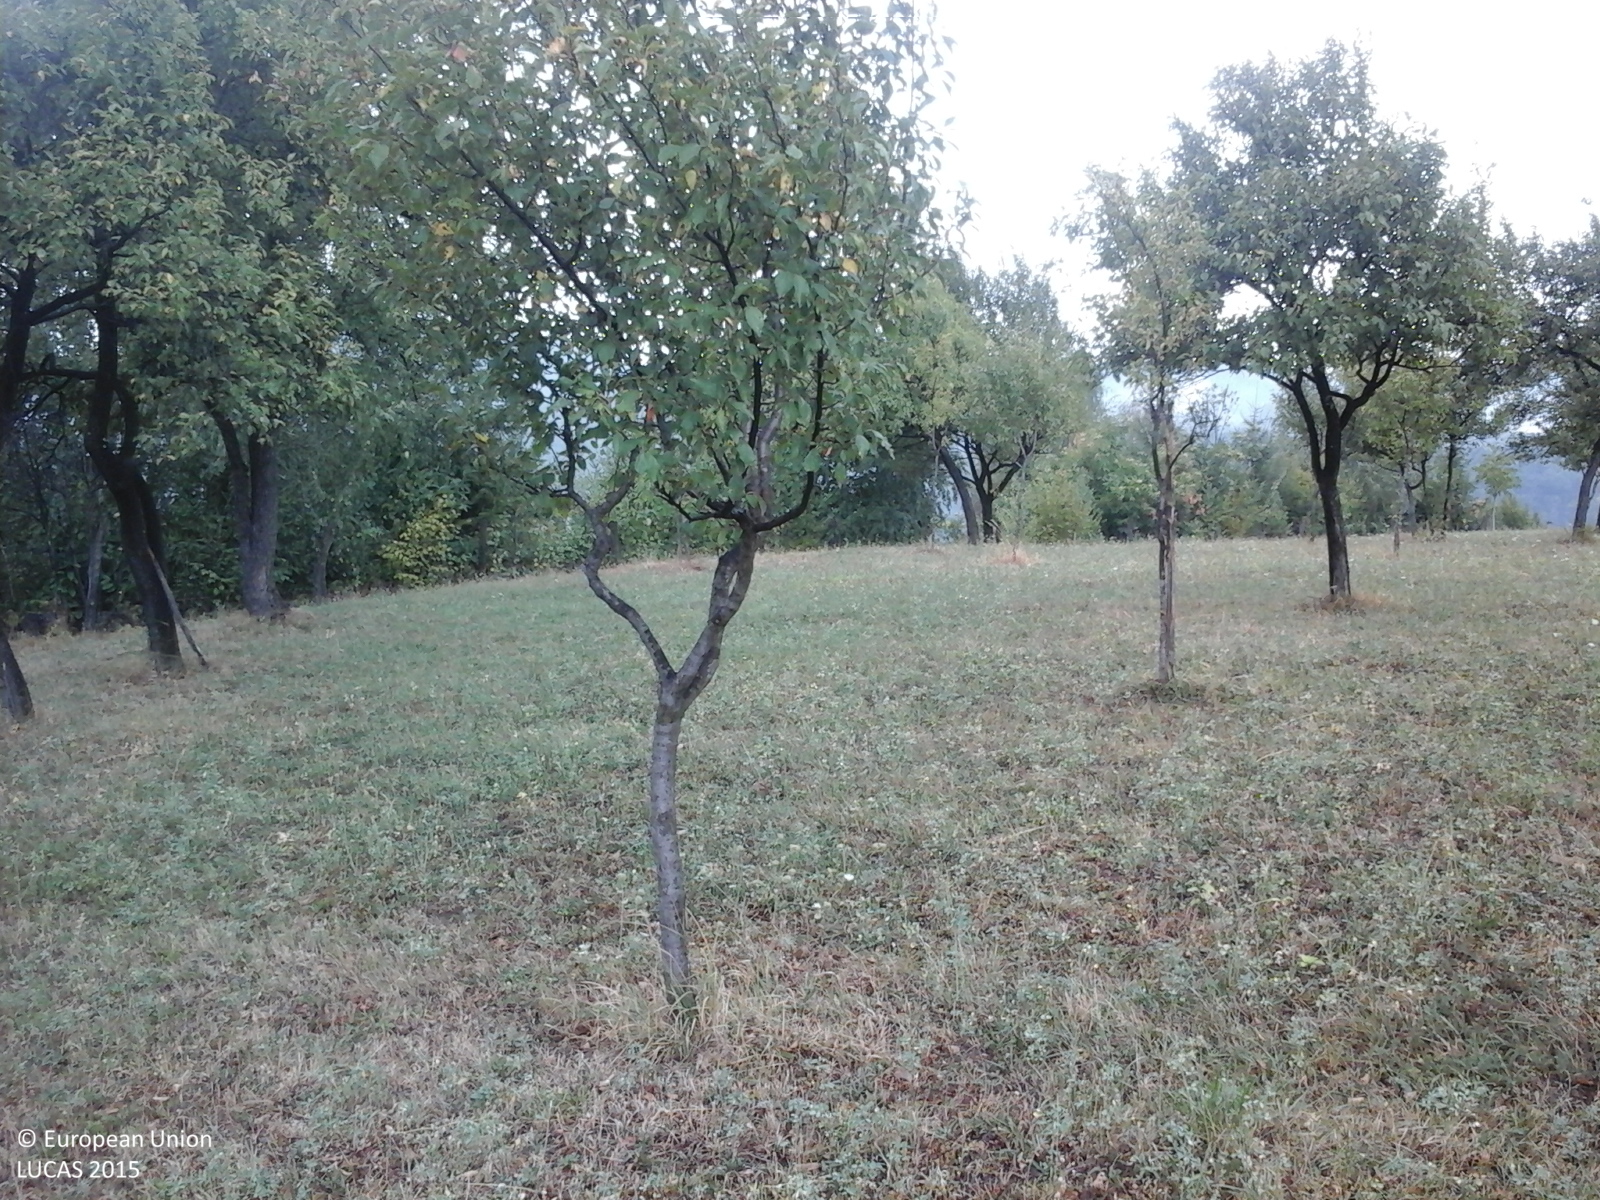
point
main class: Cropland
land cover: Apple fruit
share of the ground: 50 - 75 %
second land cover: Grassland without tree/shrub cover
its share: > 75 %
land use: Agriculture (excluding fallow land and kitchen gardens)
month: September
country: RO
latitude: 47.6653
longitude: 23.6203
